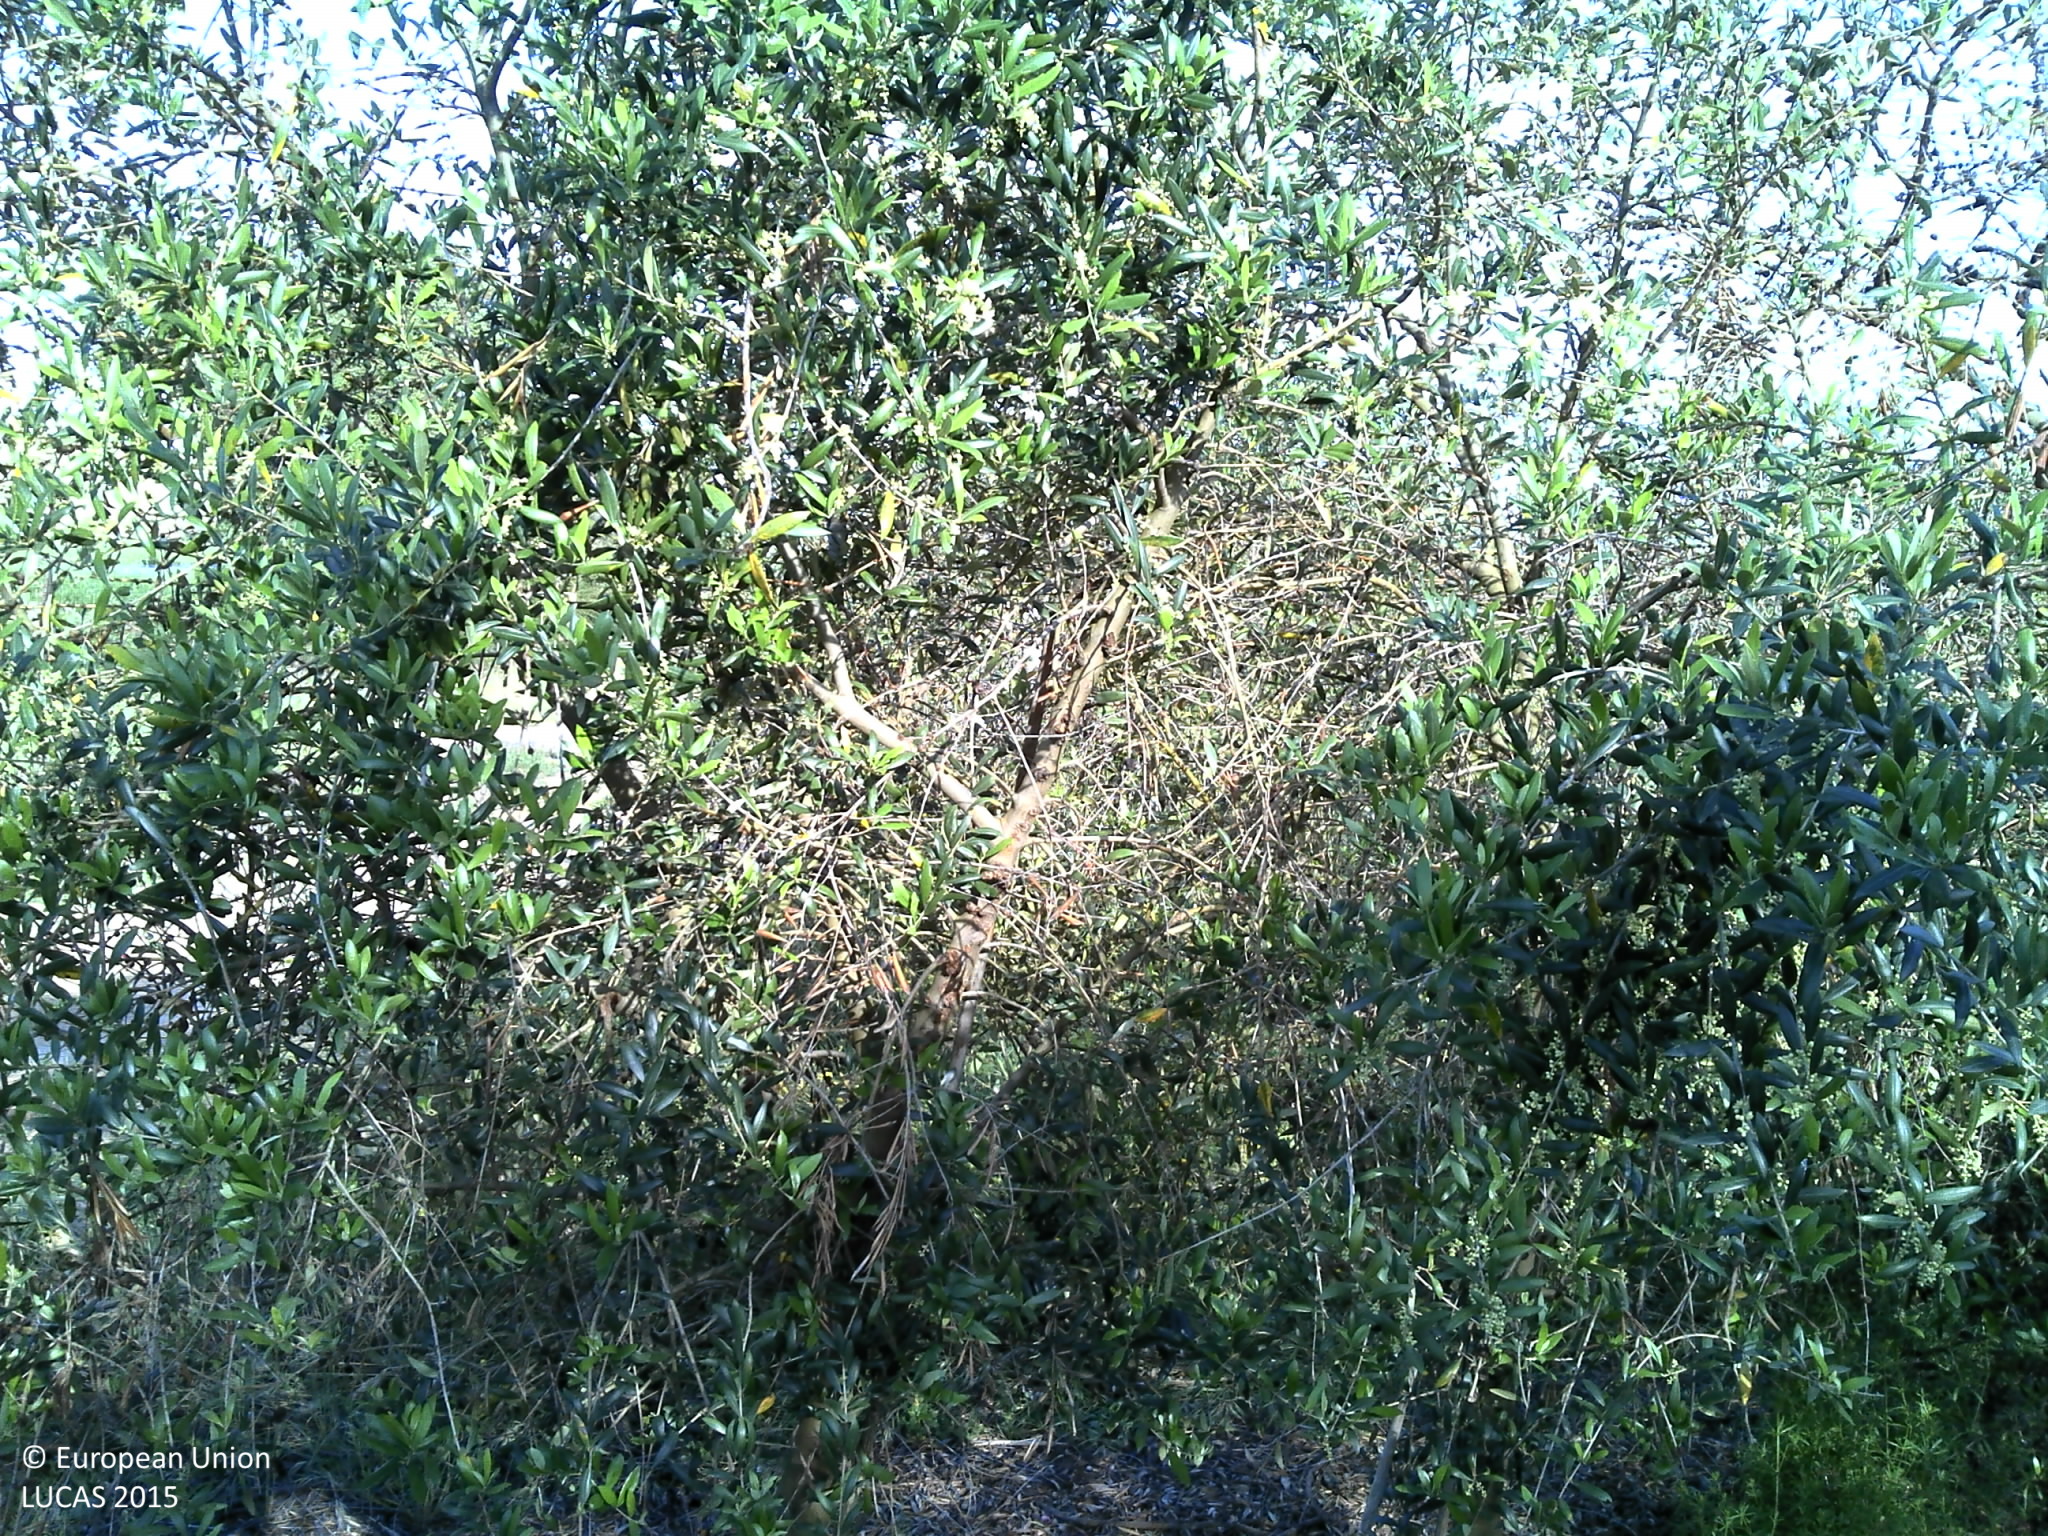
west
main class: Cropland
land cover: Olive groves
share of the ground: 25 - 50 %
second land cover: Grassland without tree/shrub cover
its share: 25 - 50 %
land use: Agriculture (excluding fallow land and kitchen gardens)
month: May
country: PT
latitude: 39.0445
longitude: -7.8280
